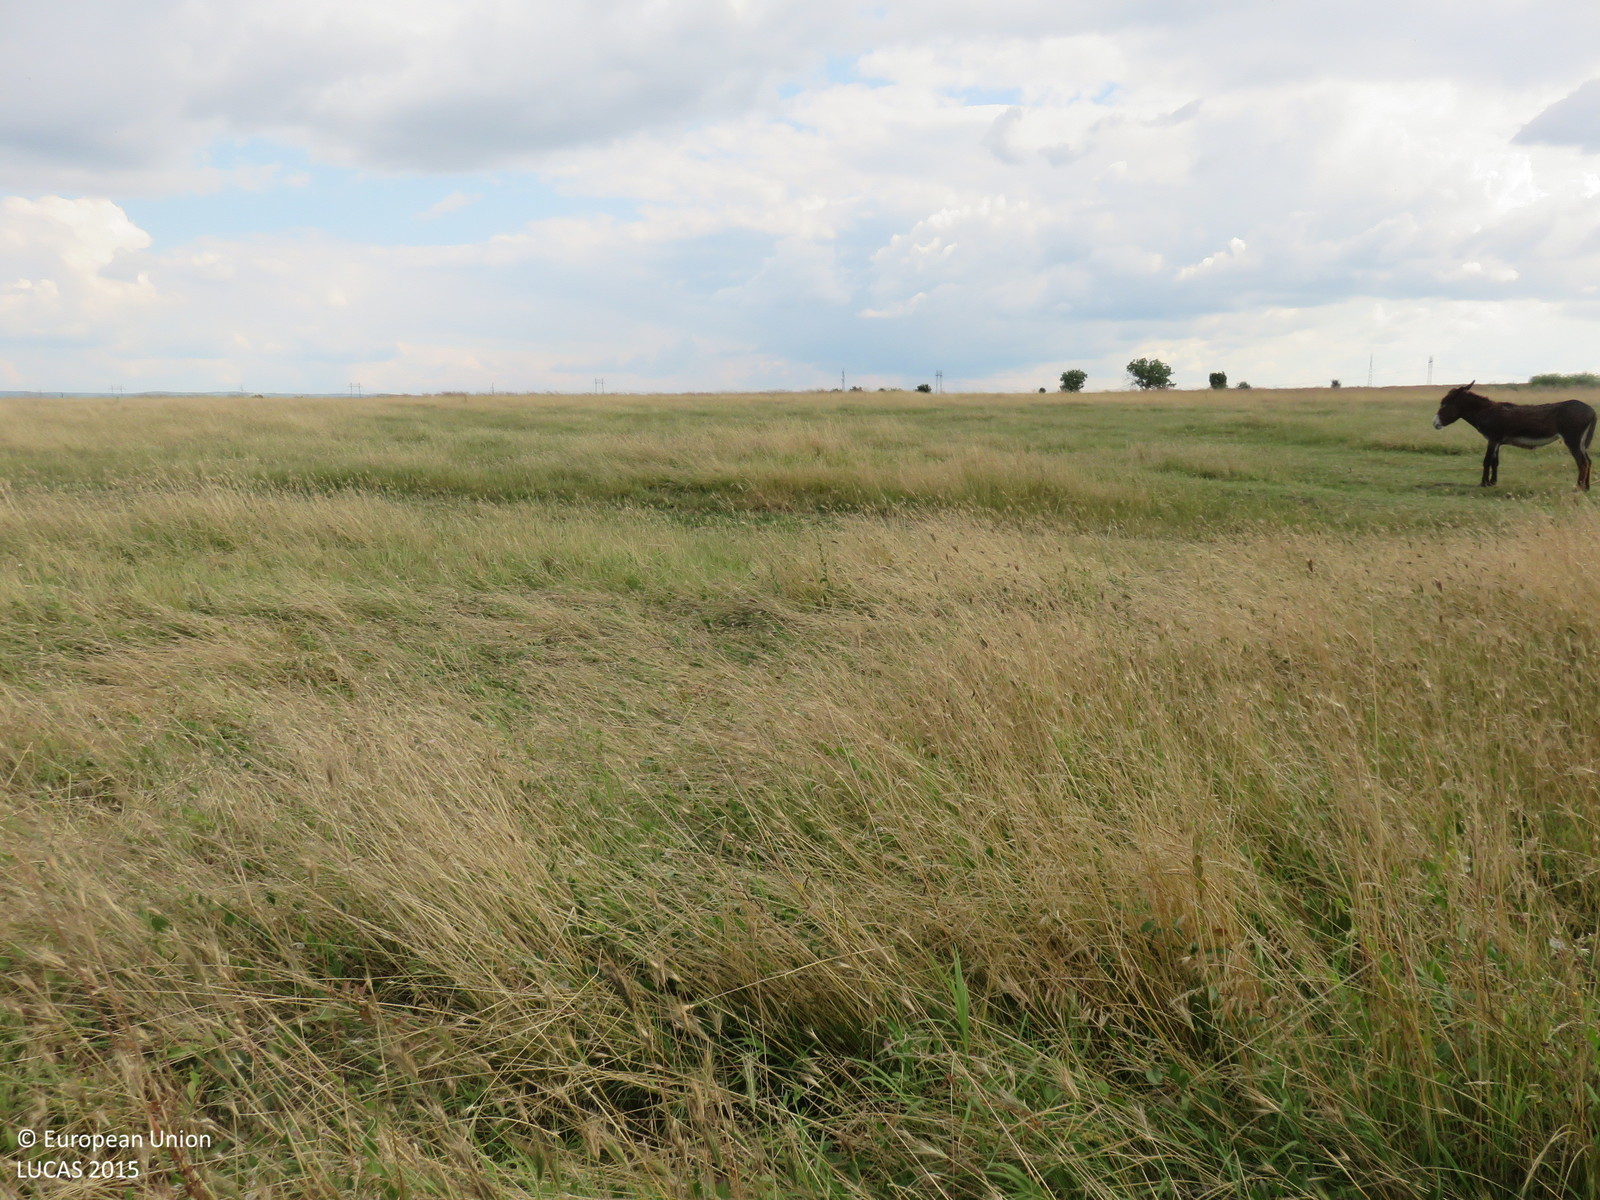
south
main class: Grassland
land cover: Grassland without tree/shrub cover
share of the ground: > 75 %
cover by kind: herbaceous plants 100 %
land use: Residential
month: June
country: BG
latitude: 43.3364
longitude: 24.9309
